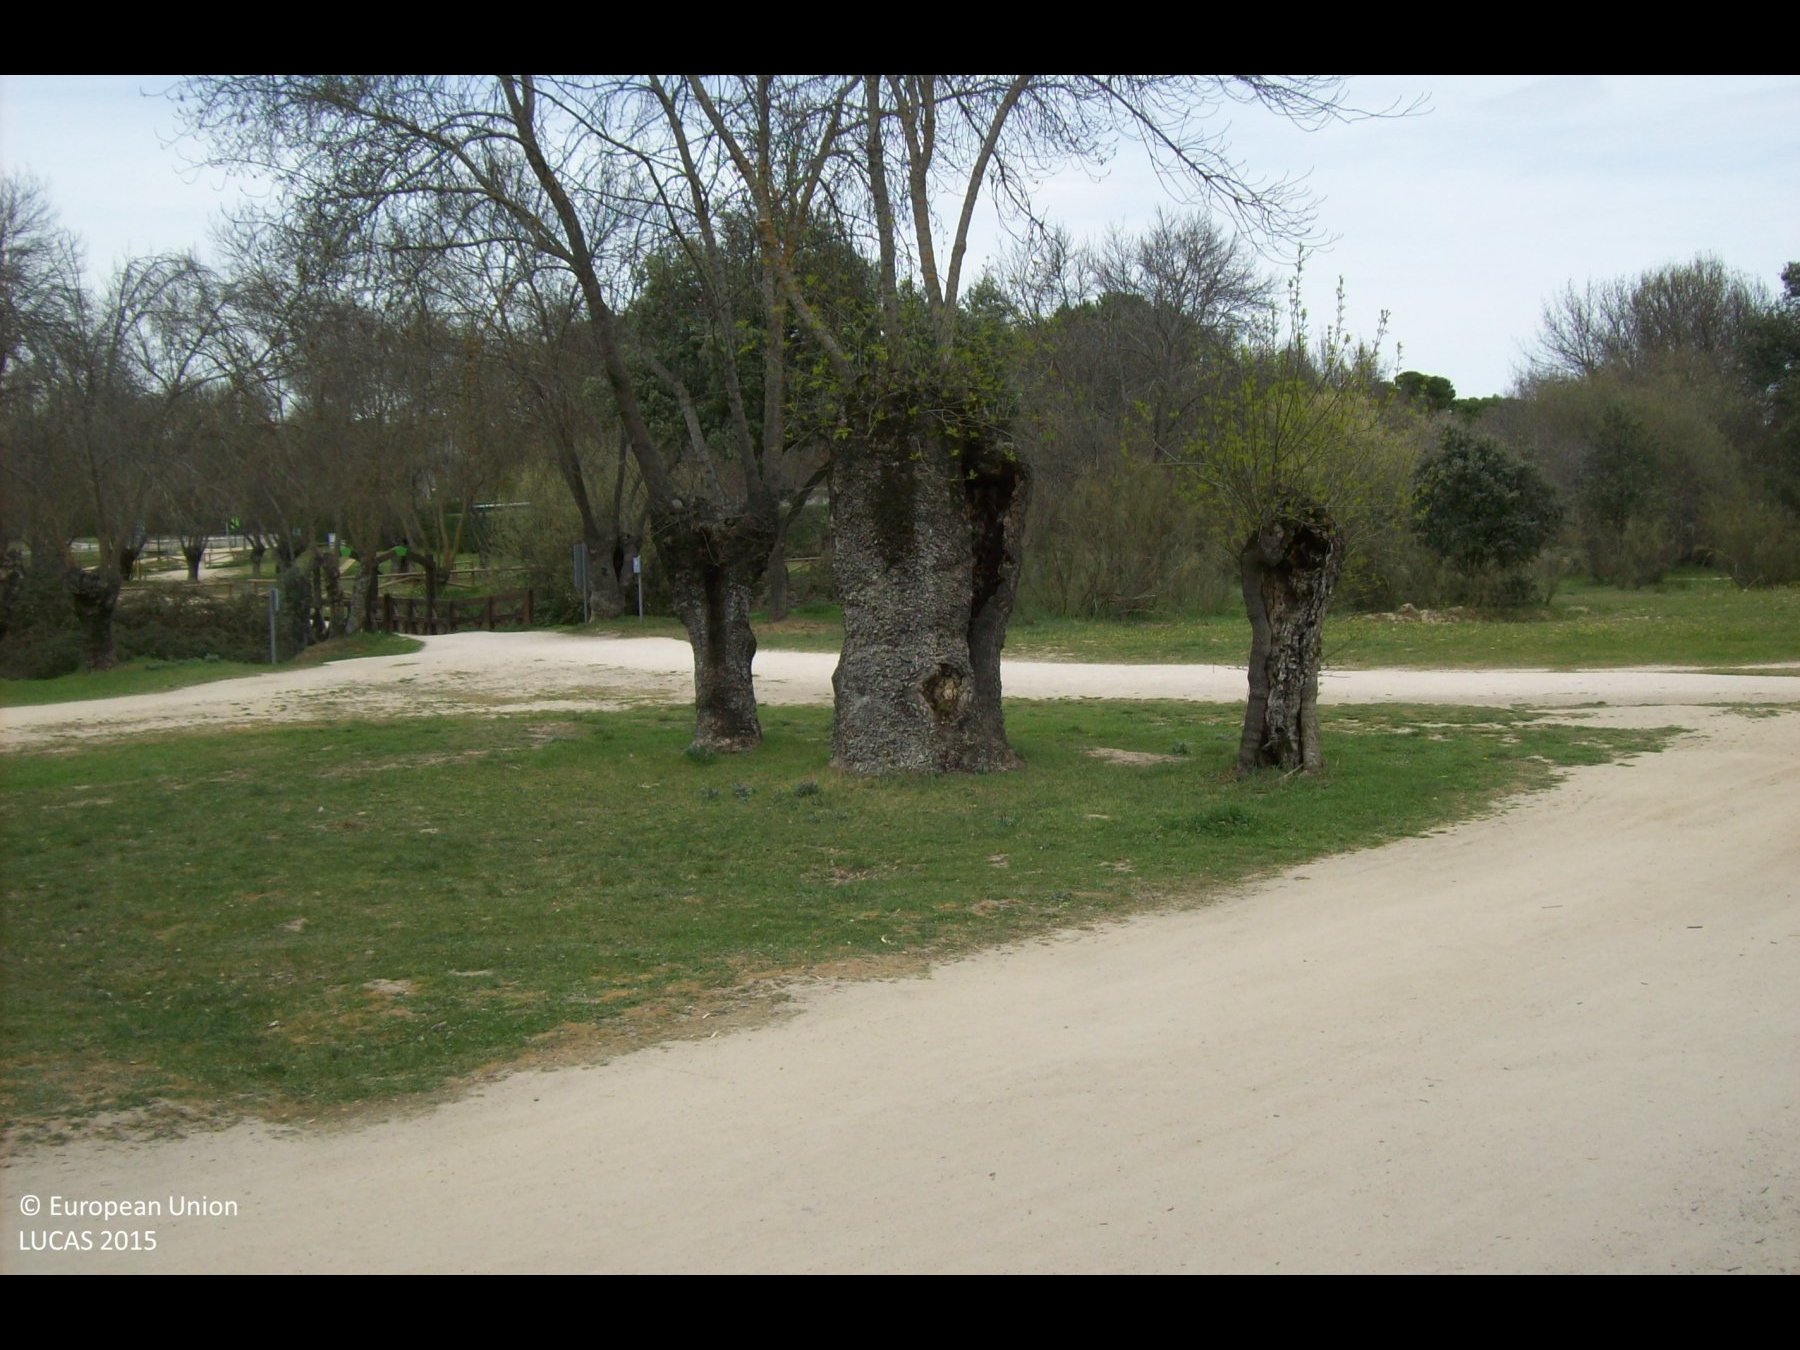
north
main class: Woodland
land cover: Broadleaved woodland
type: thermophilous deciduous forest
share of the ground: 25 - 50 %
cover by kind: broadleaved forest trees 45 %, herbaceous plants 45 %
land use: Amenities, museums, leisure
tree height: > 5 m
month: April
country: ES
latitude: 40.4139
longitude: -3.8632
